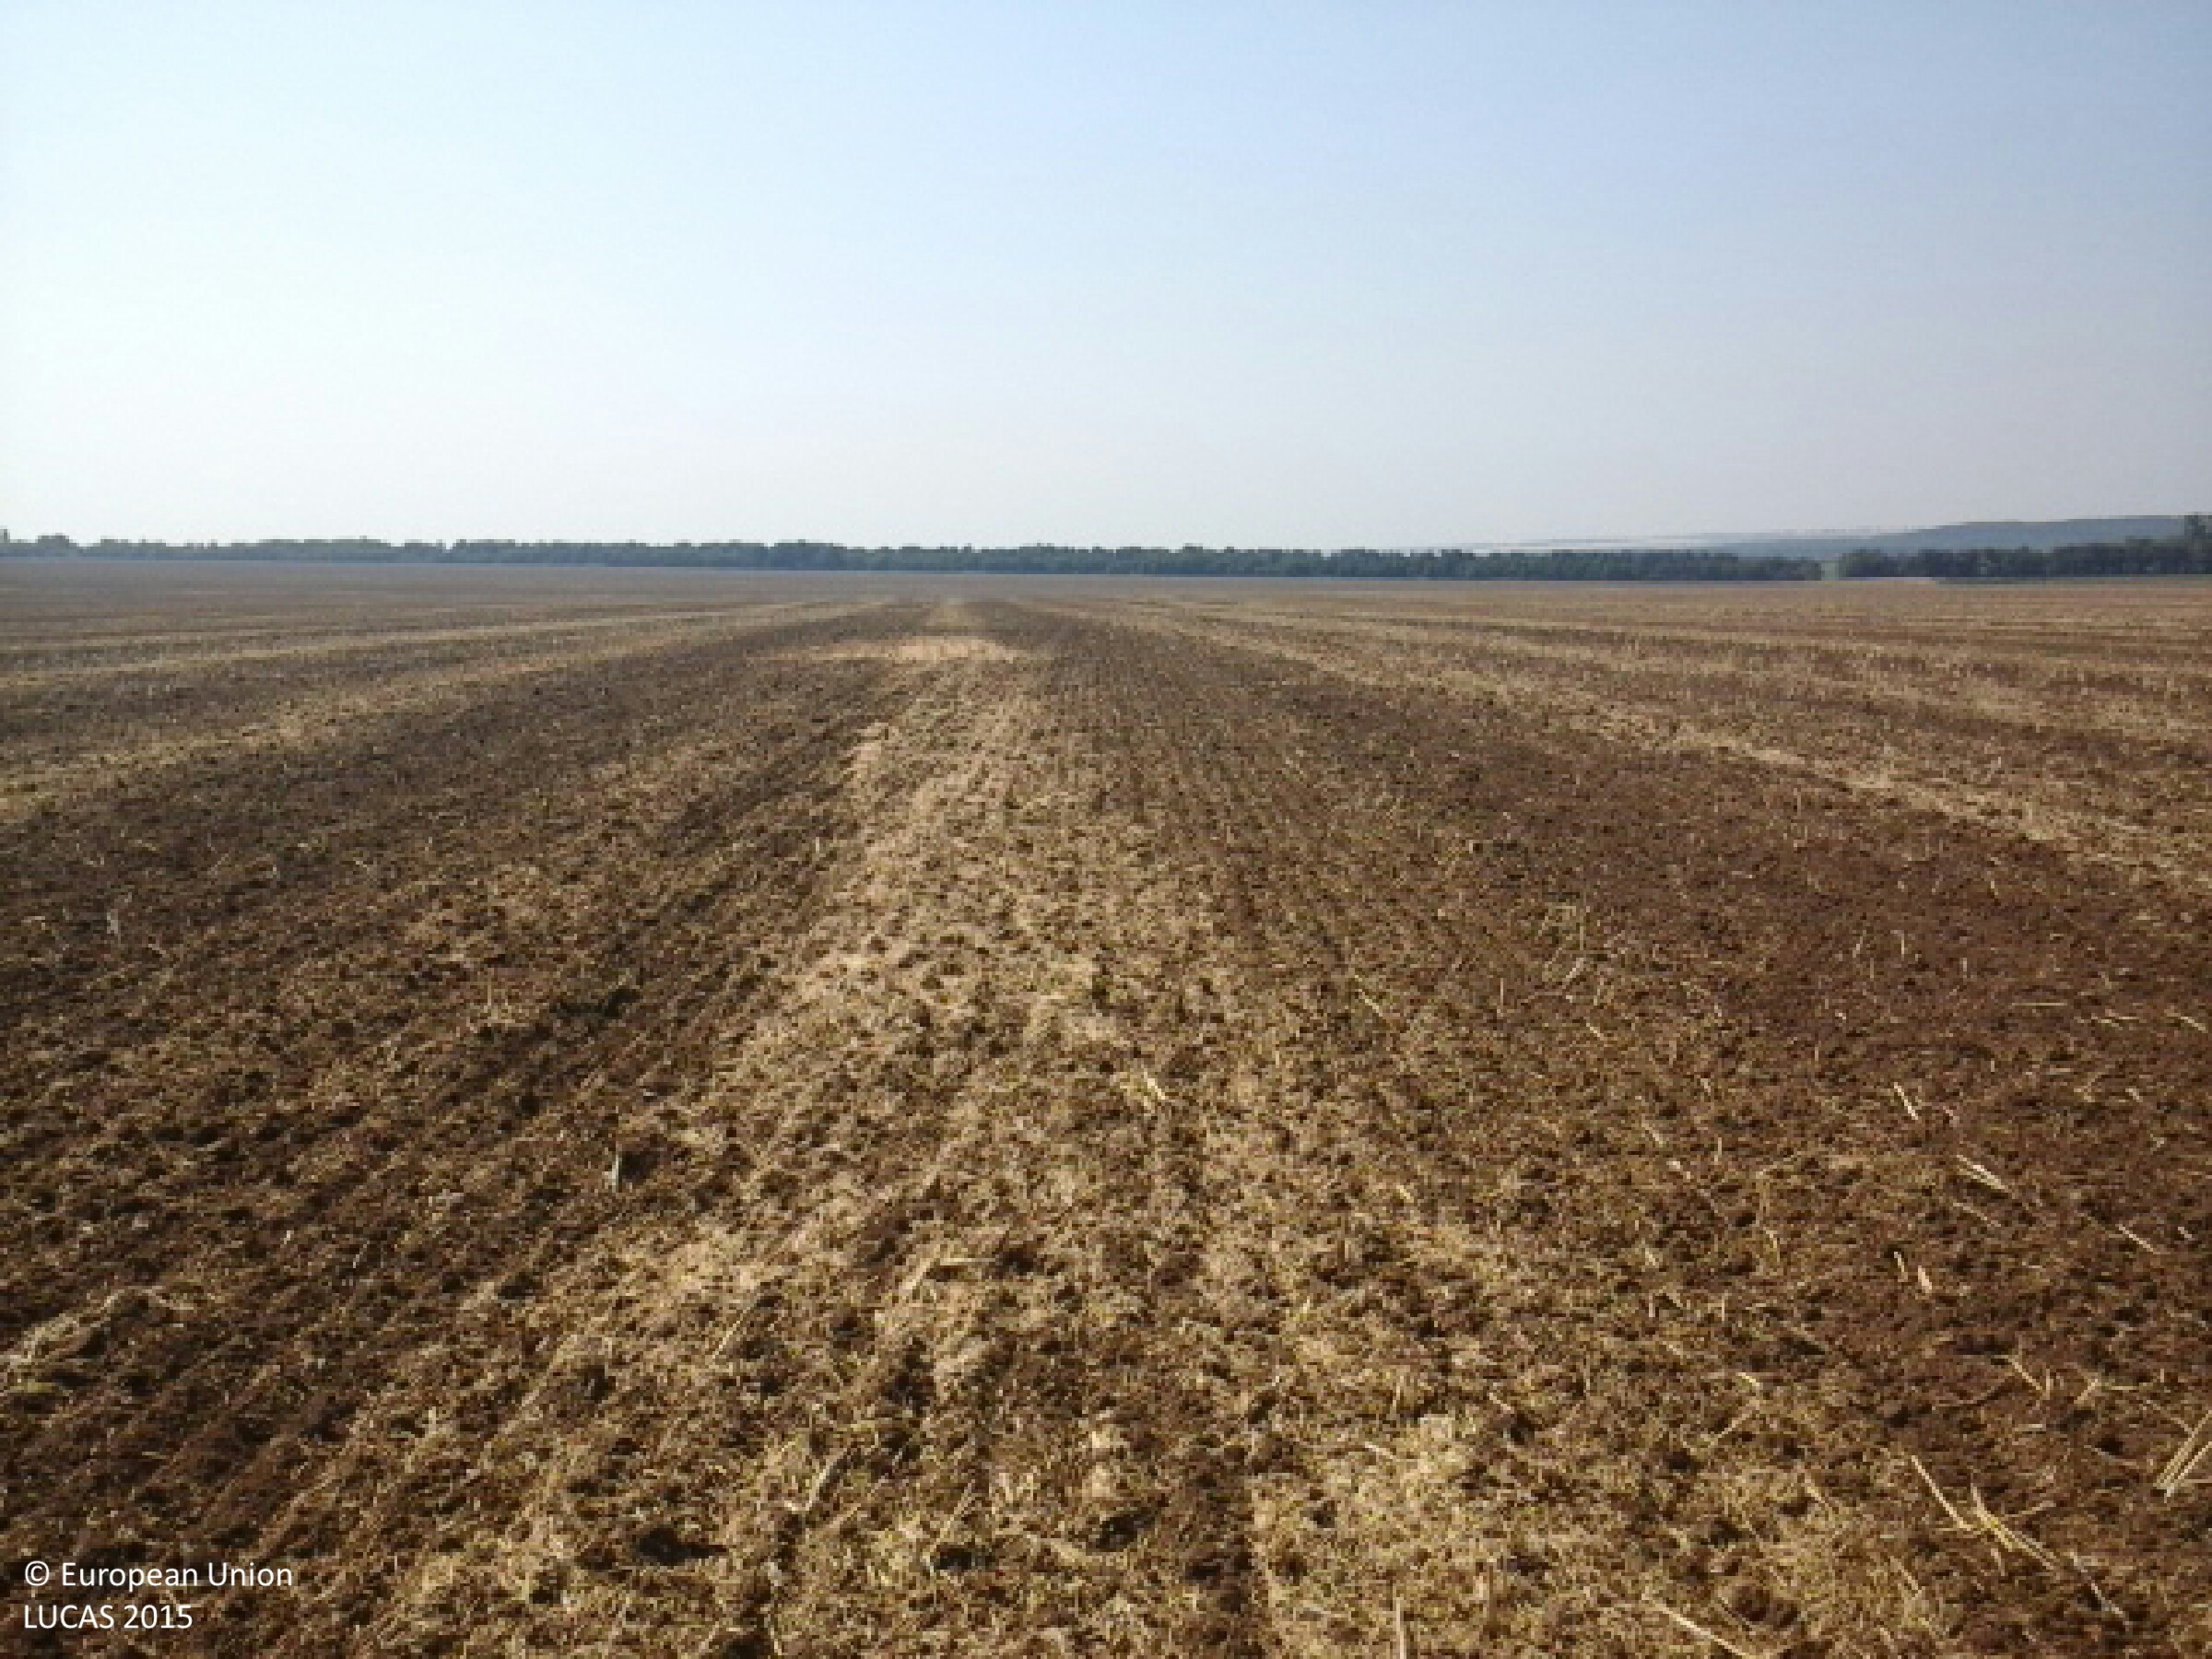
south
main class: Cropland
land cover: Rape and turnip rape
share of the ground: < 10 %
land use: Agriculture (excluding fallow land and kitchen gardens)
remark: Harvested field
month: July
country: HU
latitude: 48.1894
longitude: 21.0845
